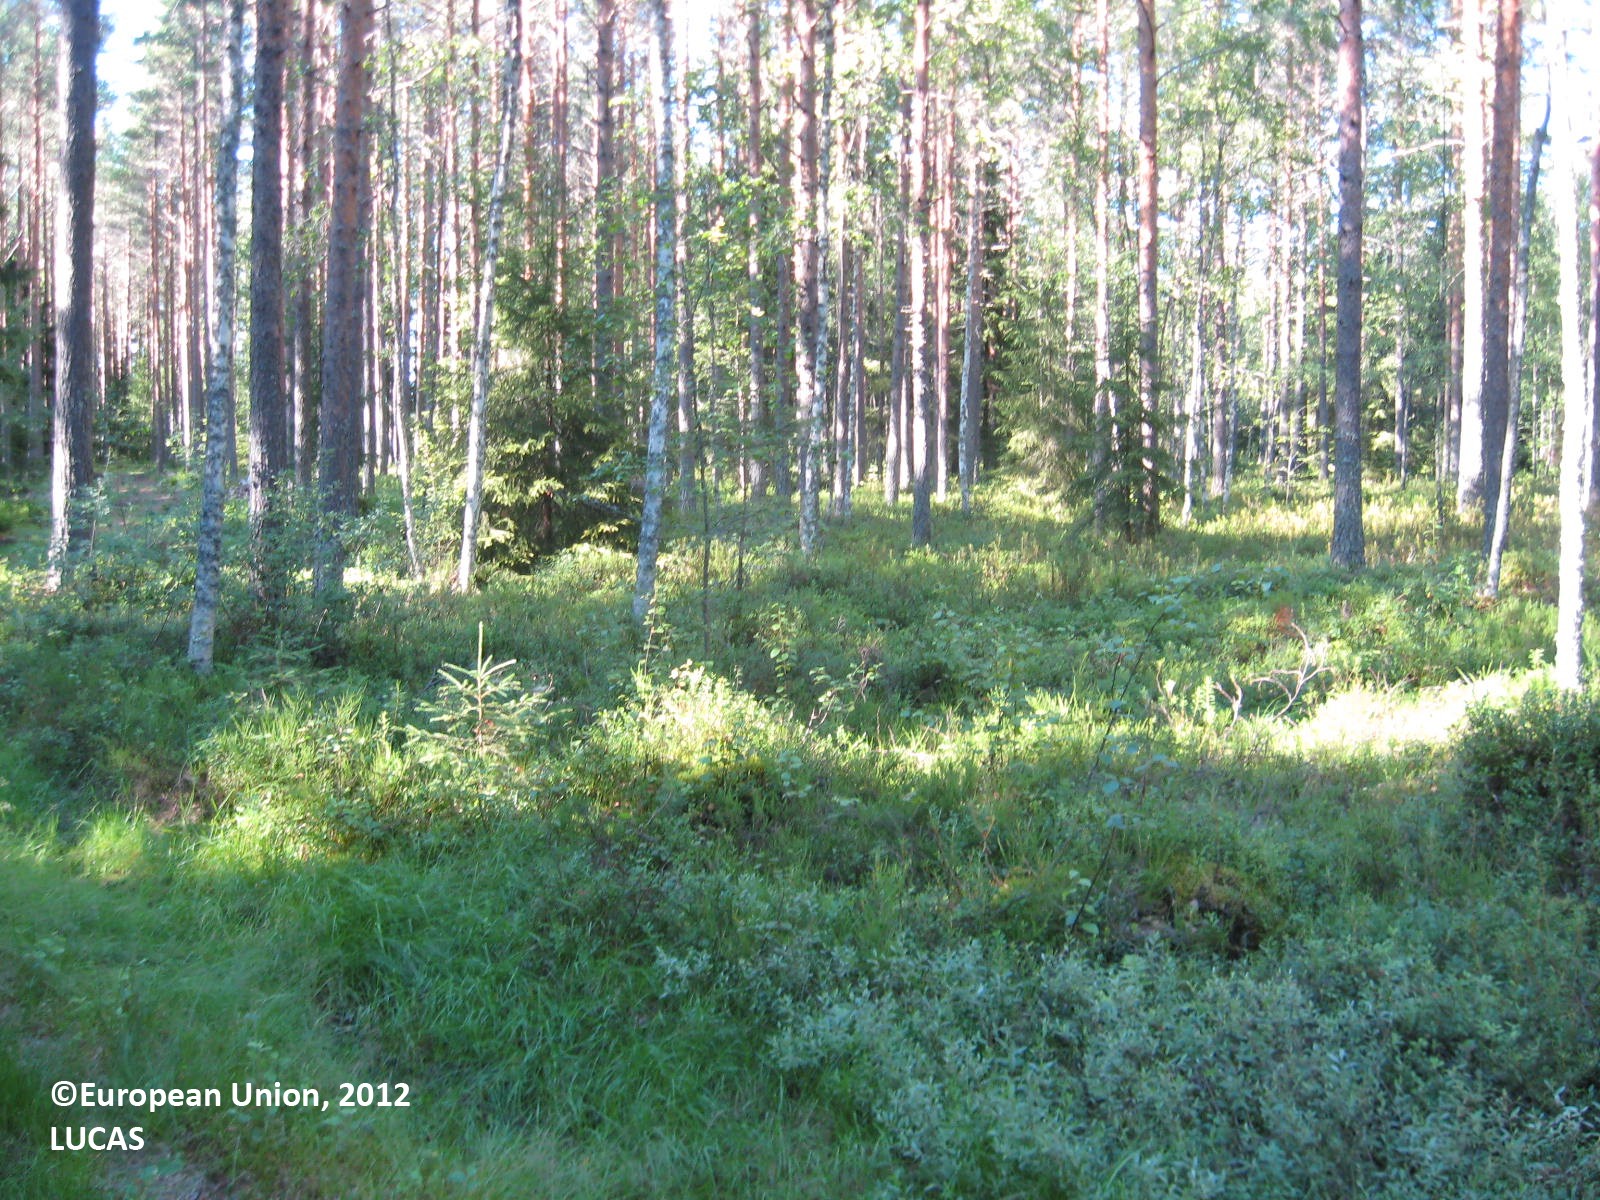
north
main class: Woodland
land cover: Pine dominated mixed woodland
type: boreal forest
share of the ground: > 75 %
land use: Forestry
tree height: > 5 m
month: July
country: FI
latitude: 62.0579
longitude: 22.4355
